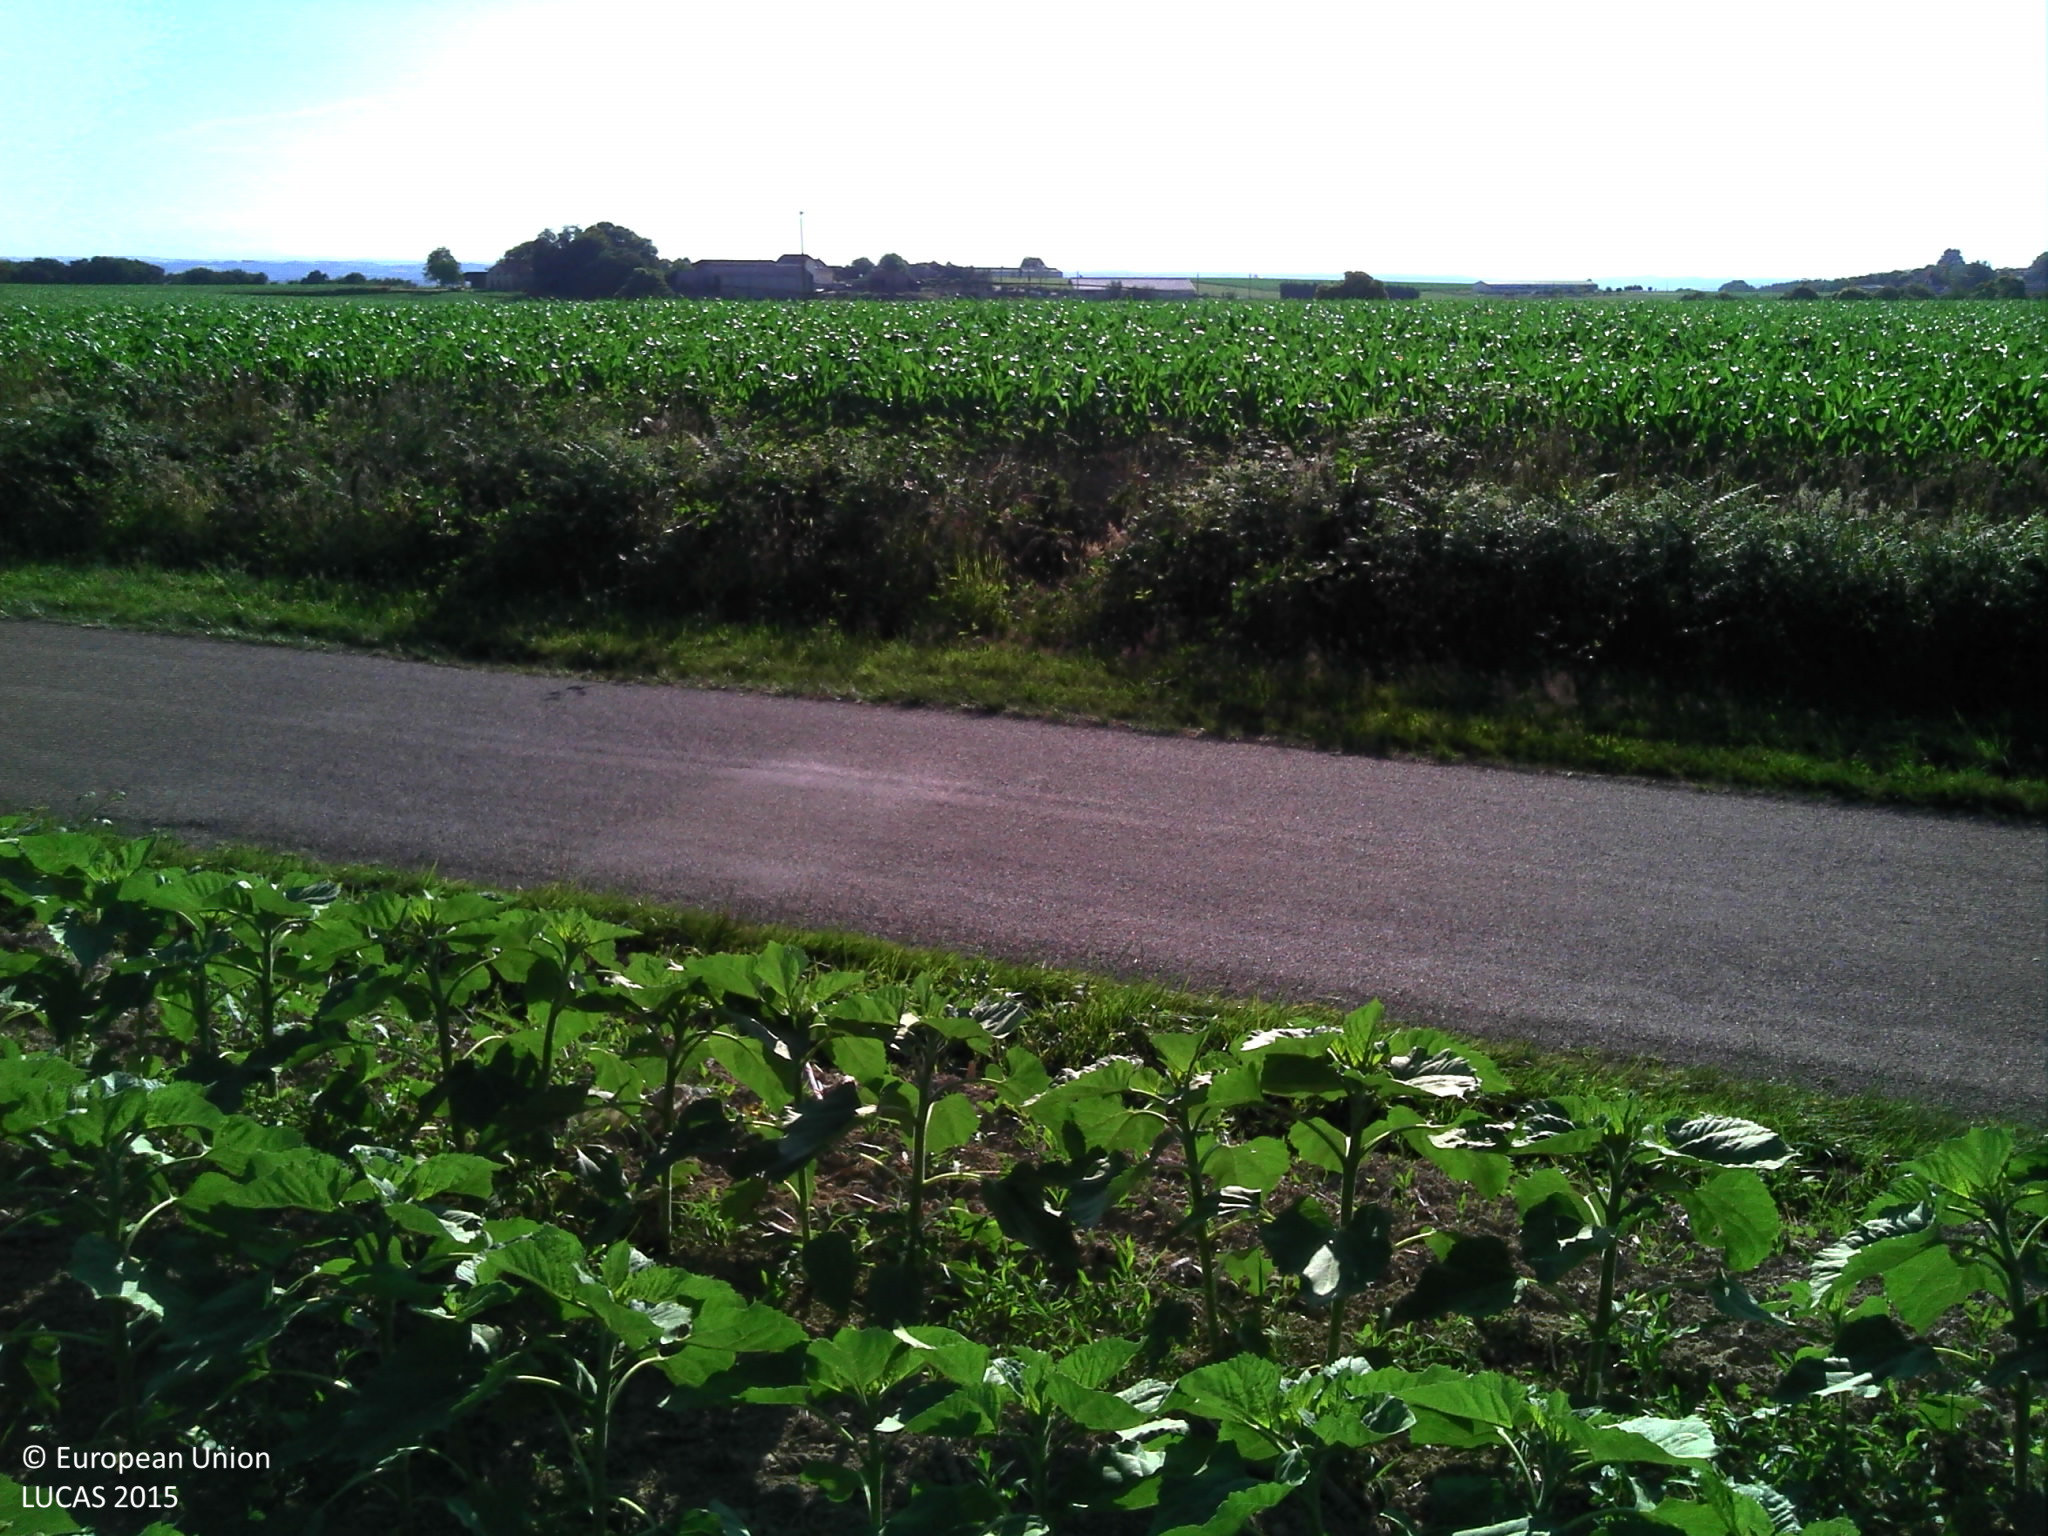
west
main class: Cropland
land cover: Sunflower
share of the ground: > 75 %
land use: Agriculture (excluding fallow land and kitchen gardens)
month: June
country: FR
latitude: 43.5674
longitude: -0.4466
